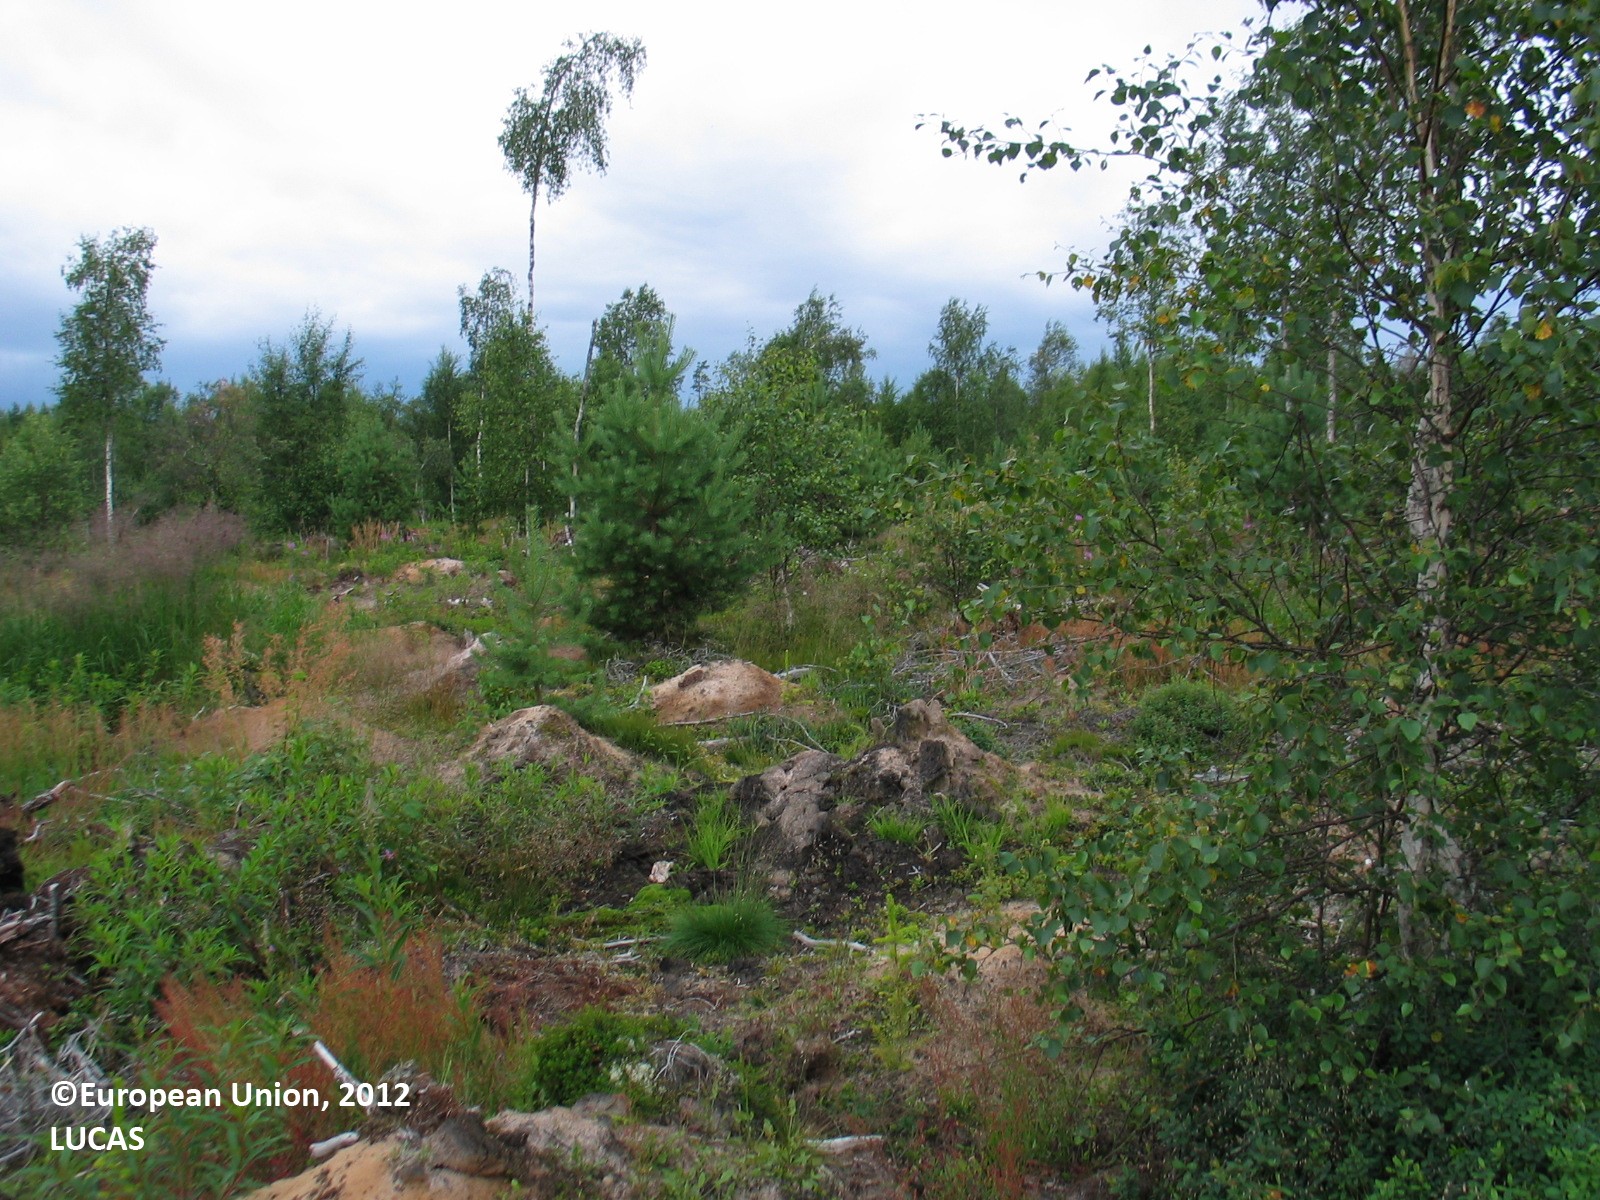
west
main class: Grassland
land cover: Grassland with sparse tree/shrub cover
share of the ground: > 75 %
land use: Forestry
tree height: < 5 m
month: July
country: FI
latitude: 64.5595
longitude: 26.3631
